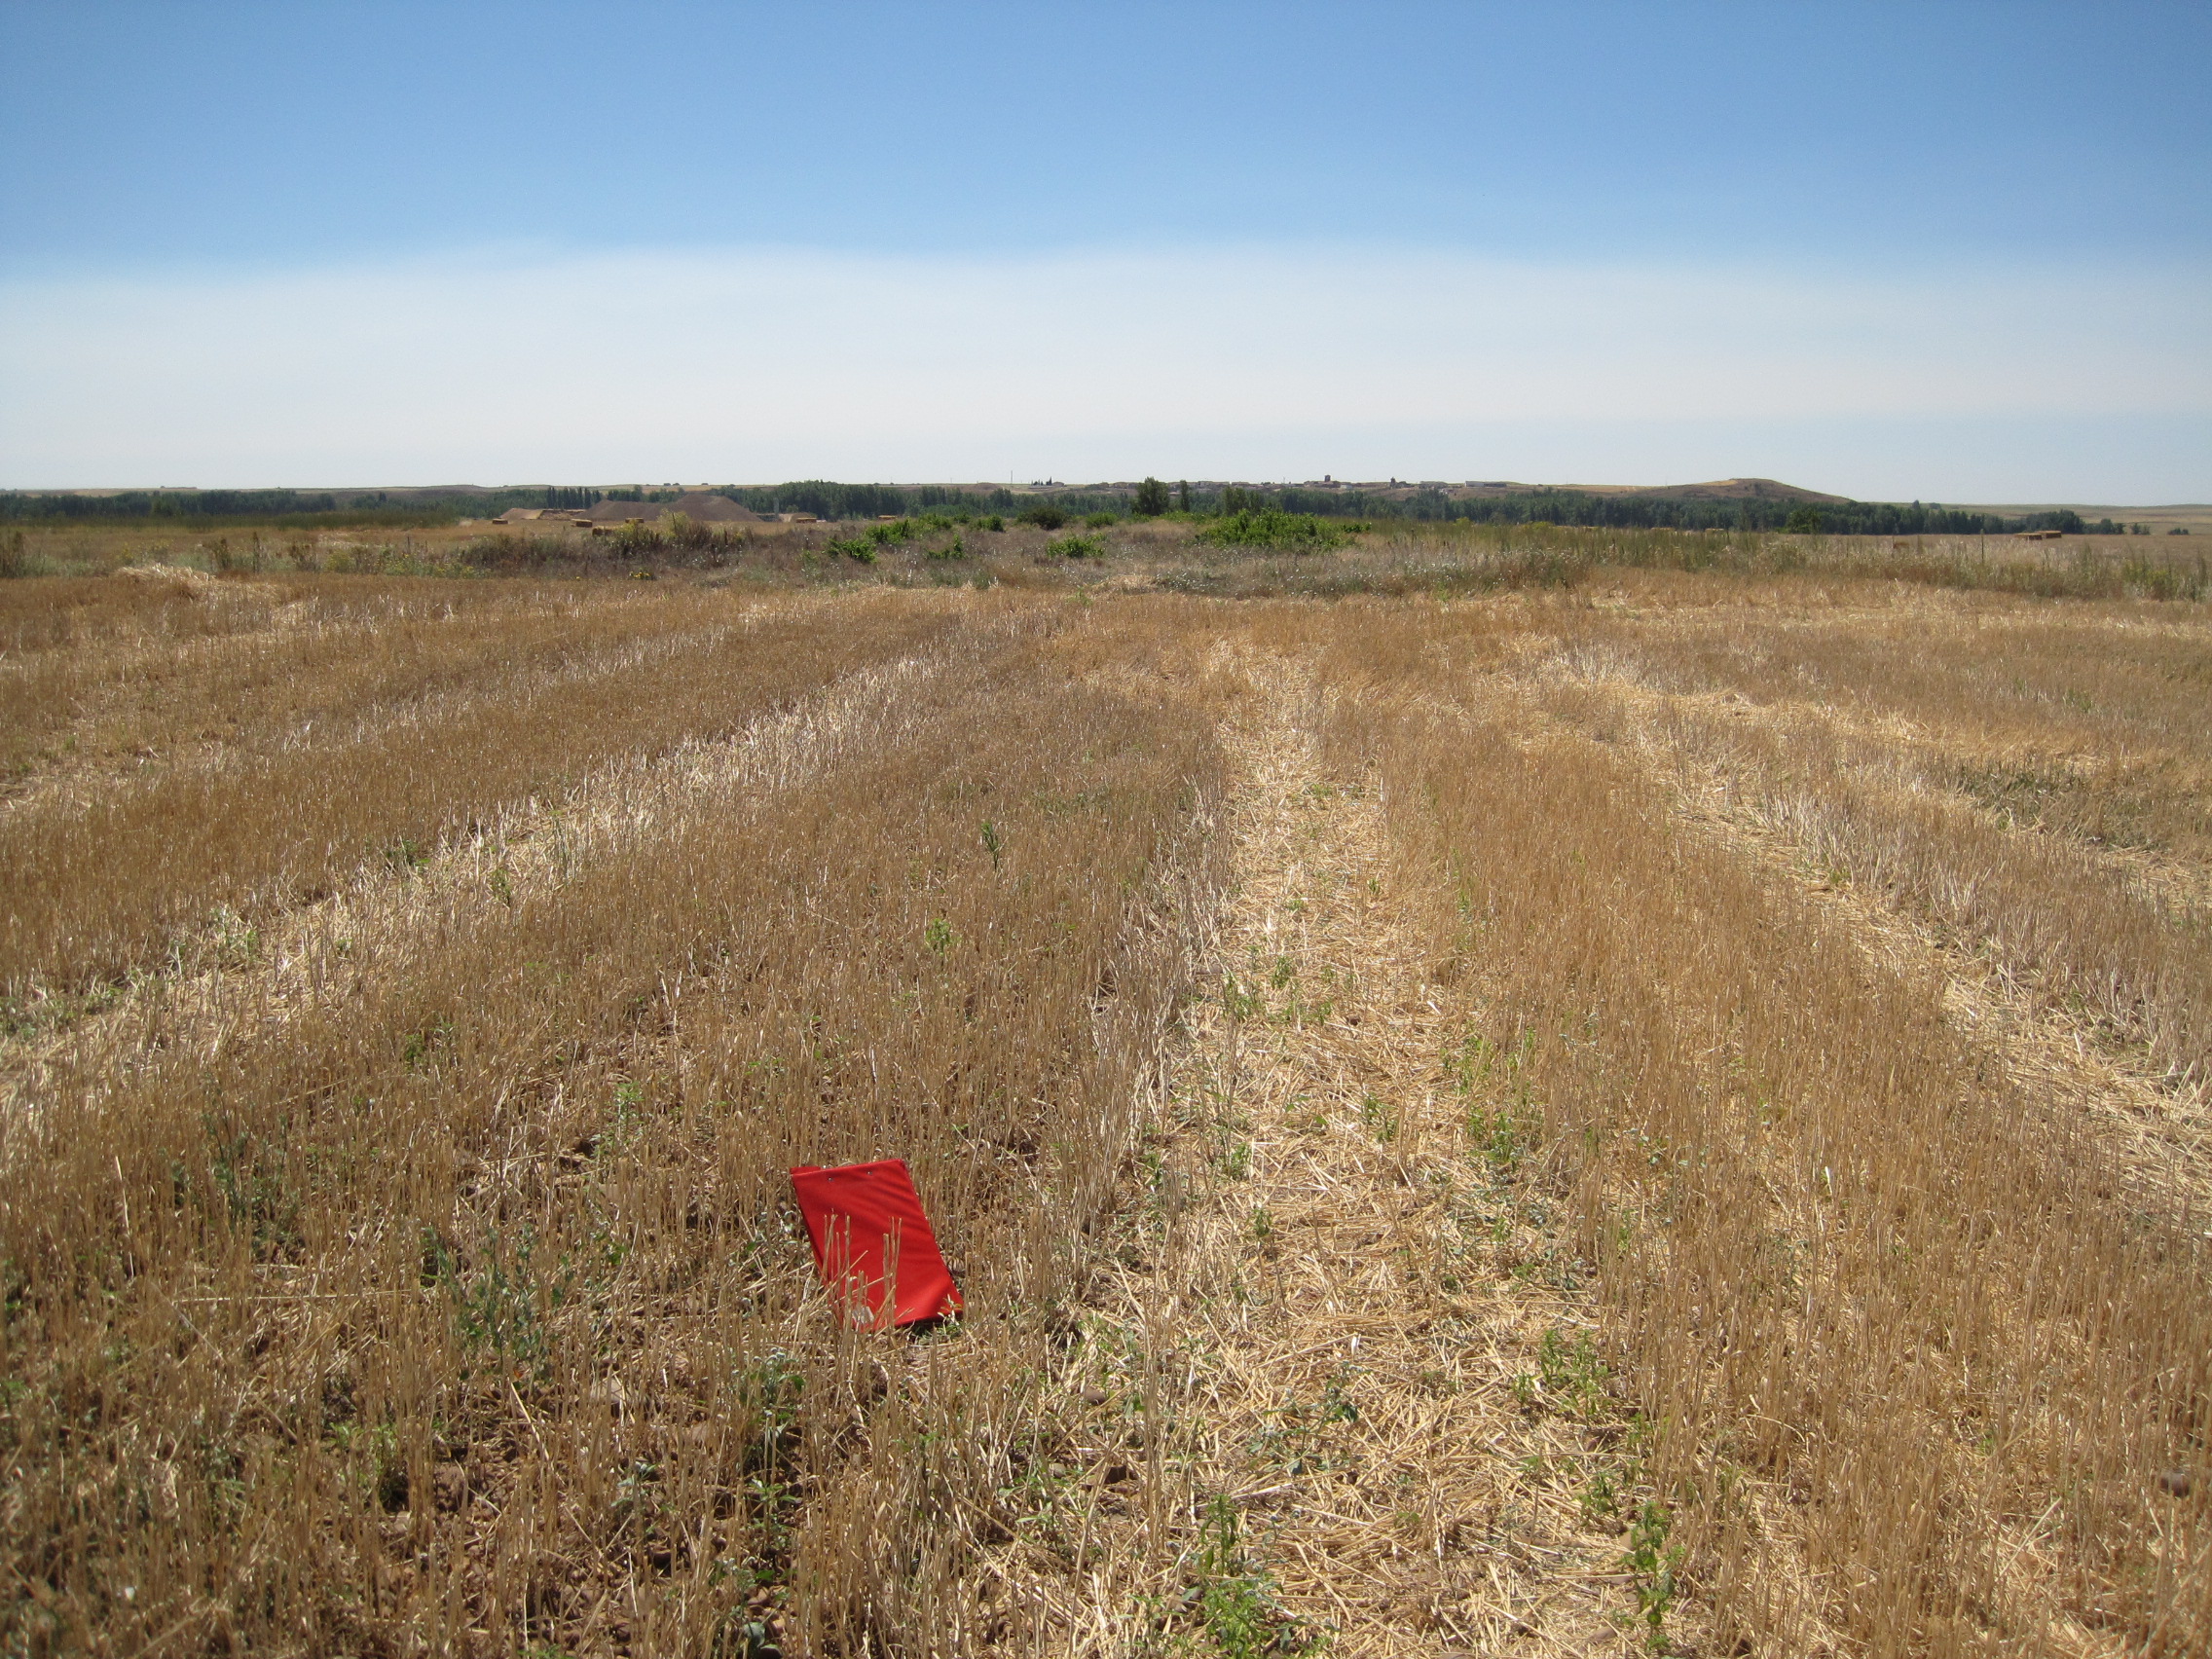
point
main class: Cropland
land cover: Common wheat
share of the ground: < 10 %
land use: Agriculture (excluding fallow land and kitchen gardens)
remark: Harvested field
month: July
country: ES
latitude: 42.1588
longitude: -5.3242
